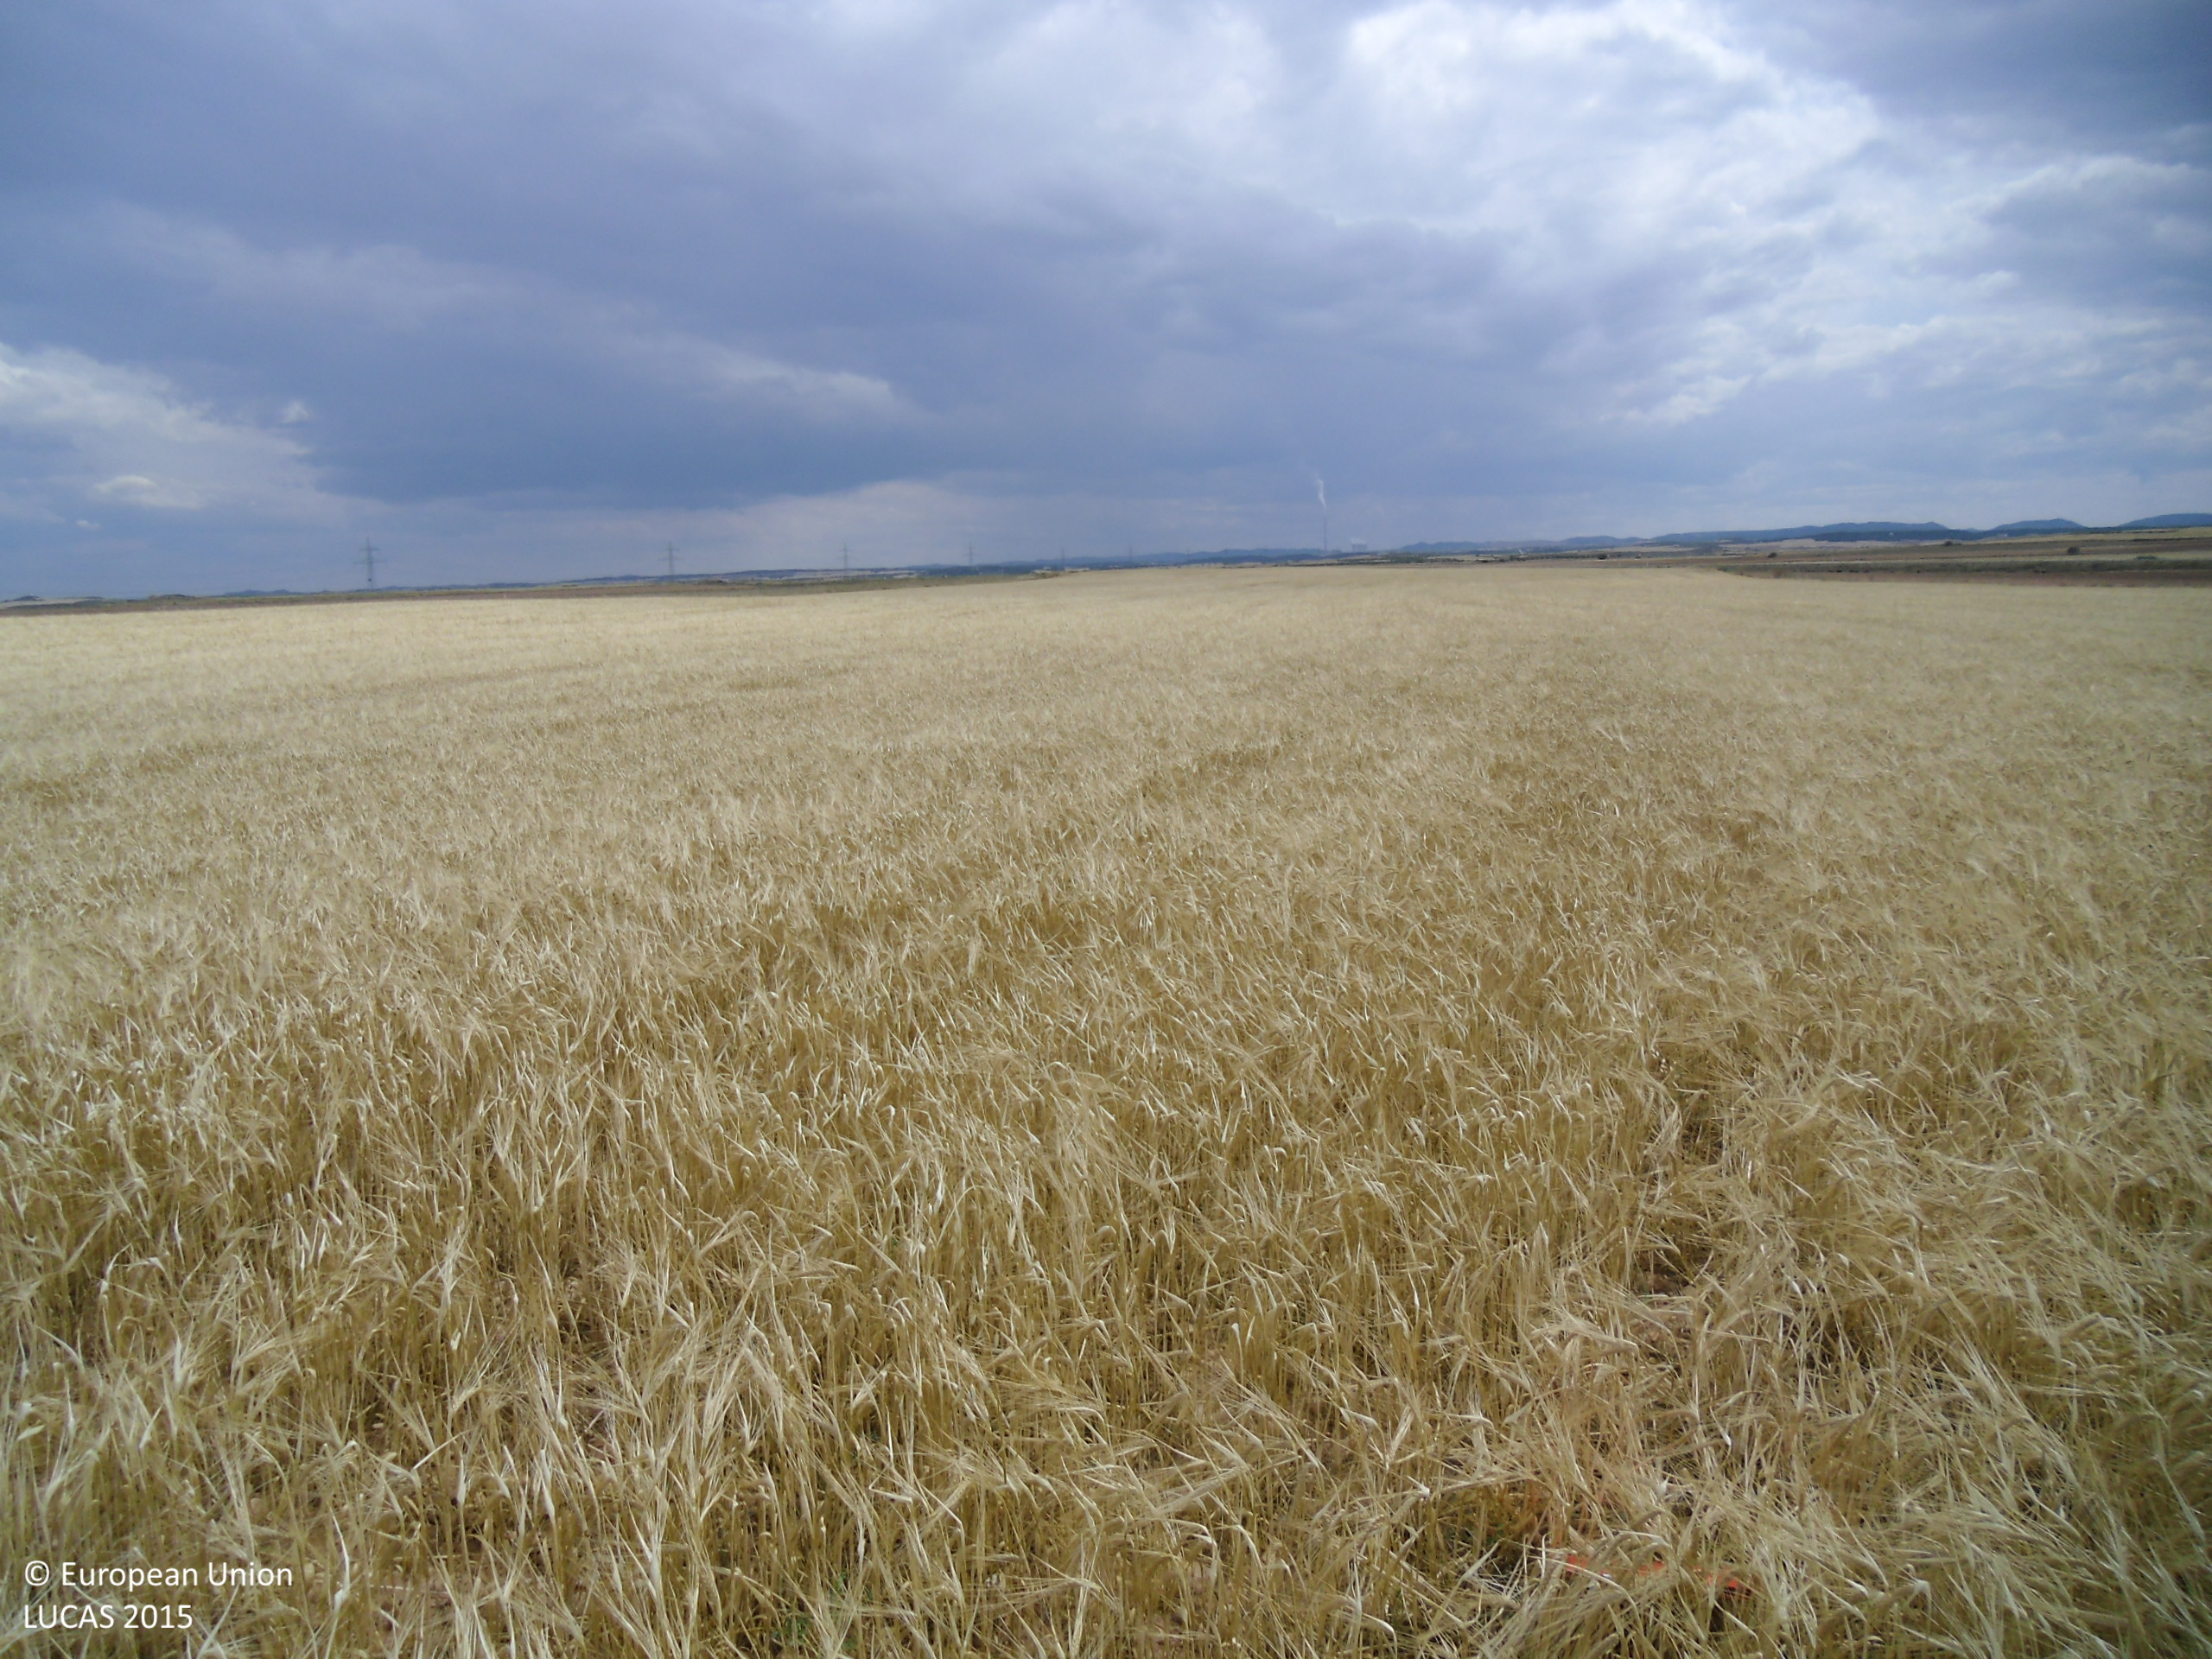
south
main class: Cropland
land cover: Rye
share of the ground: > 75 %
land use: Agriculture (excluding fallow land and kitchen gardens)
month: June
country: ES
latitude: 41.1224
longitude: -0.3397
